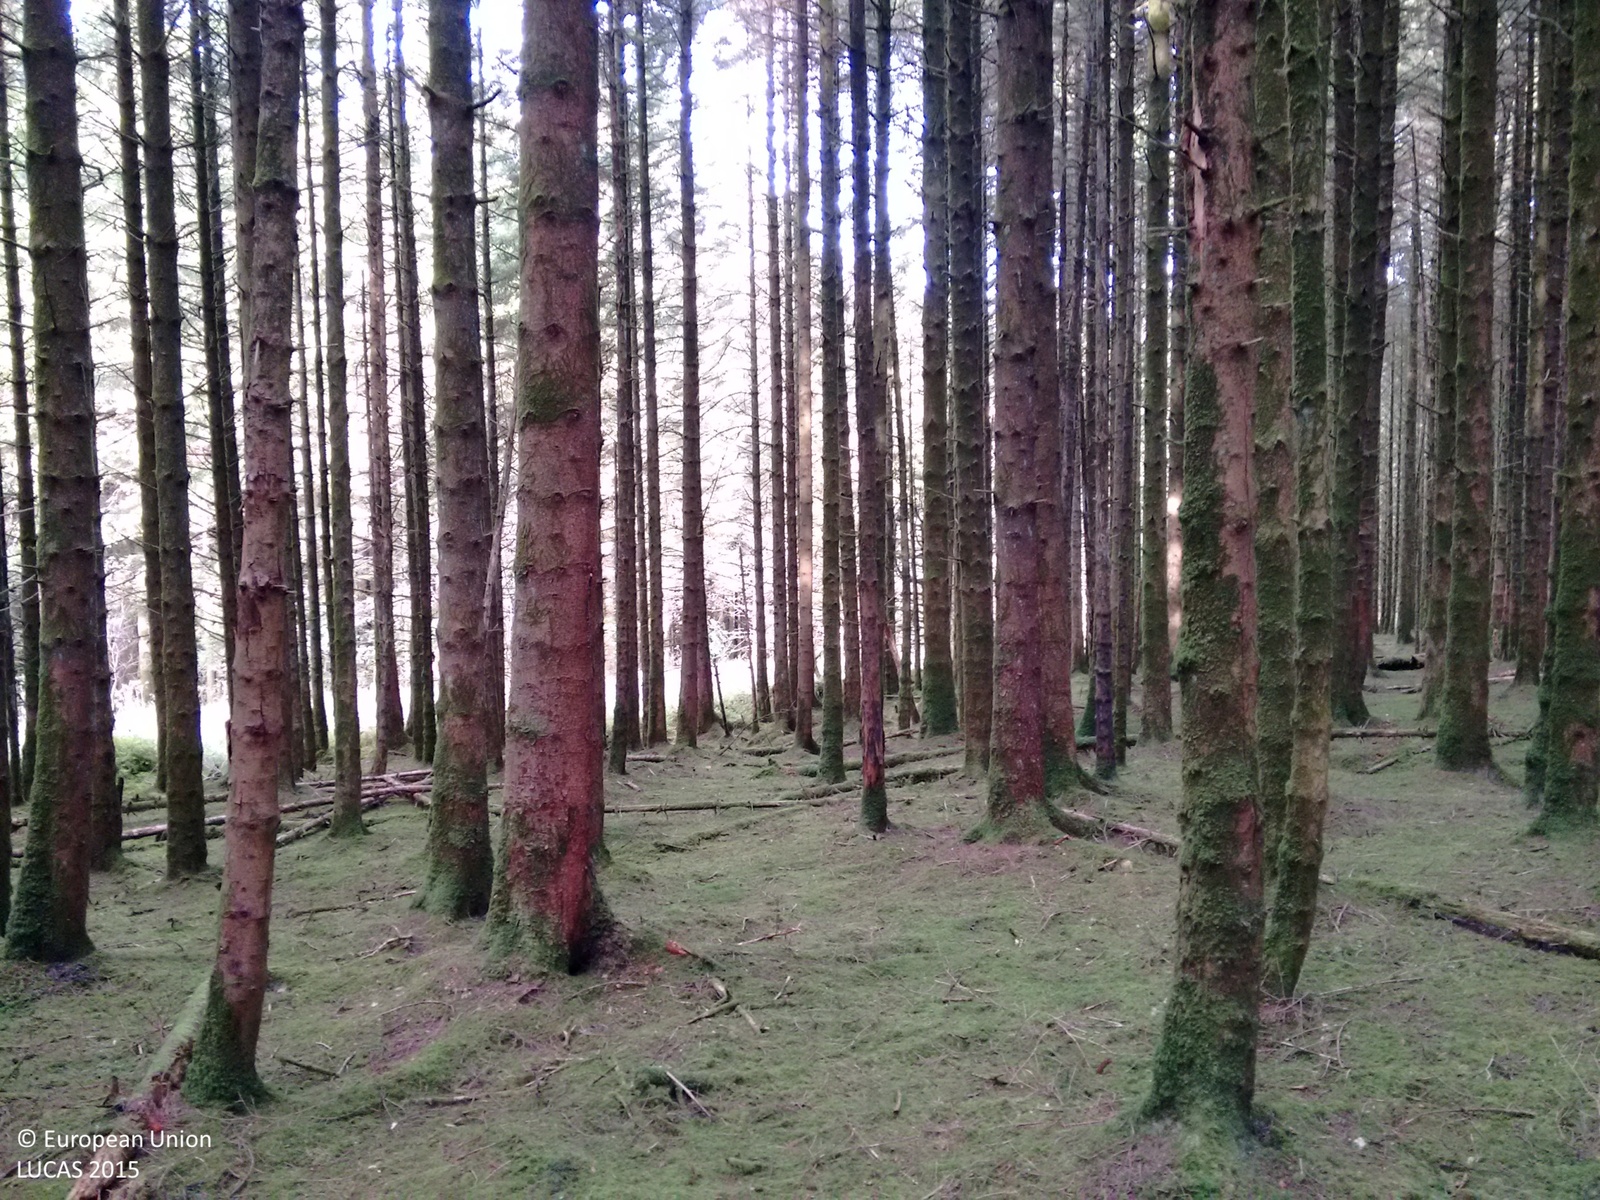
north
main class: Woodland
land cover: Spruce dominated coniferous woodland
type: exotic forest
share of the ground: > 75 %
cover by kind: coniferous forest trees 100 %
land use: Forestry
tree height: > 5 m
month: October
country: GB
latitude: 54.3310
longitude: -7.8370
